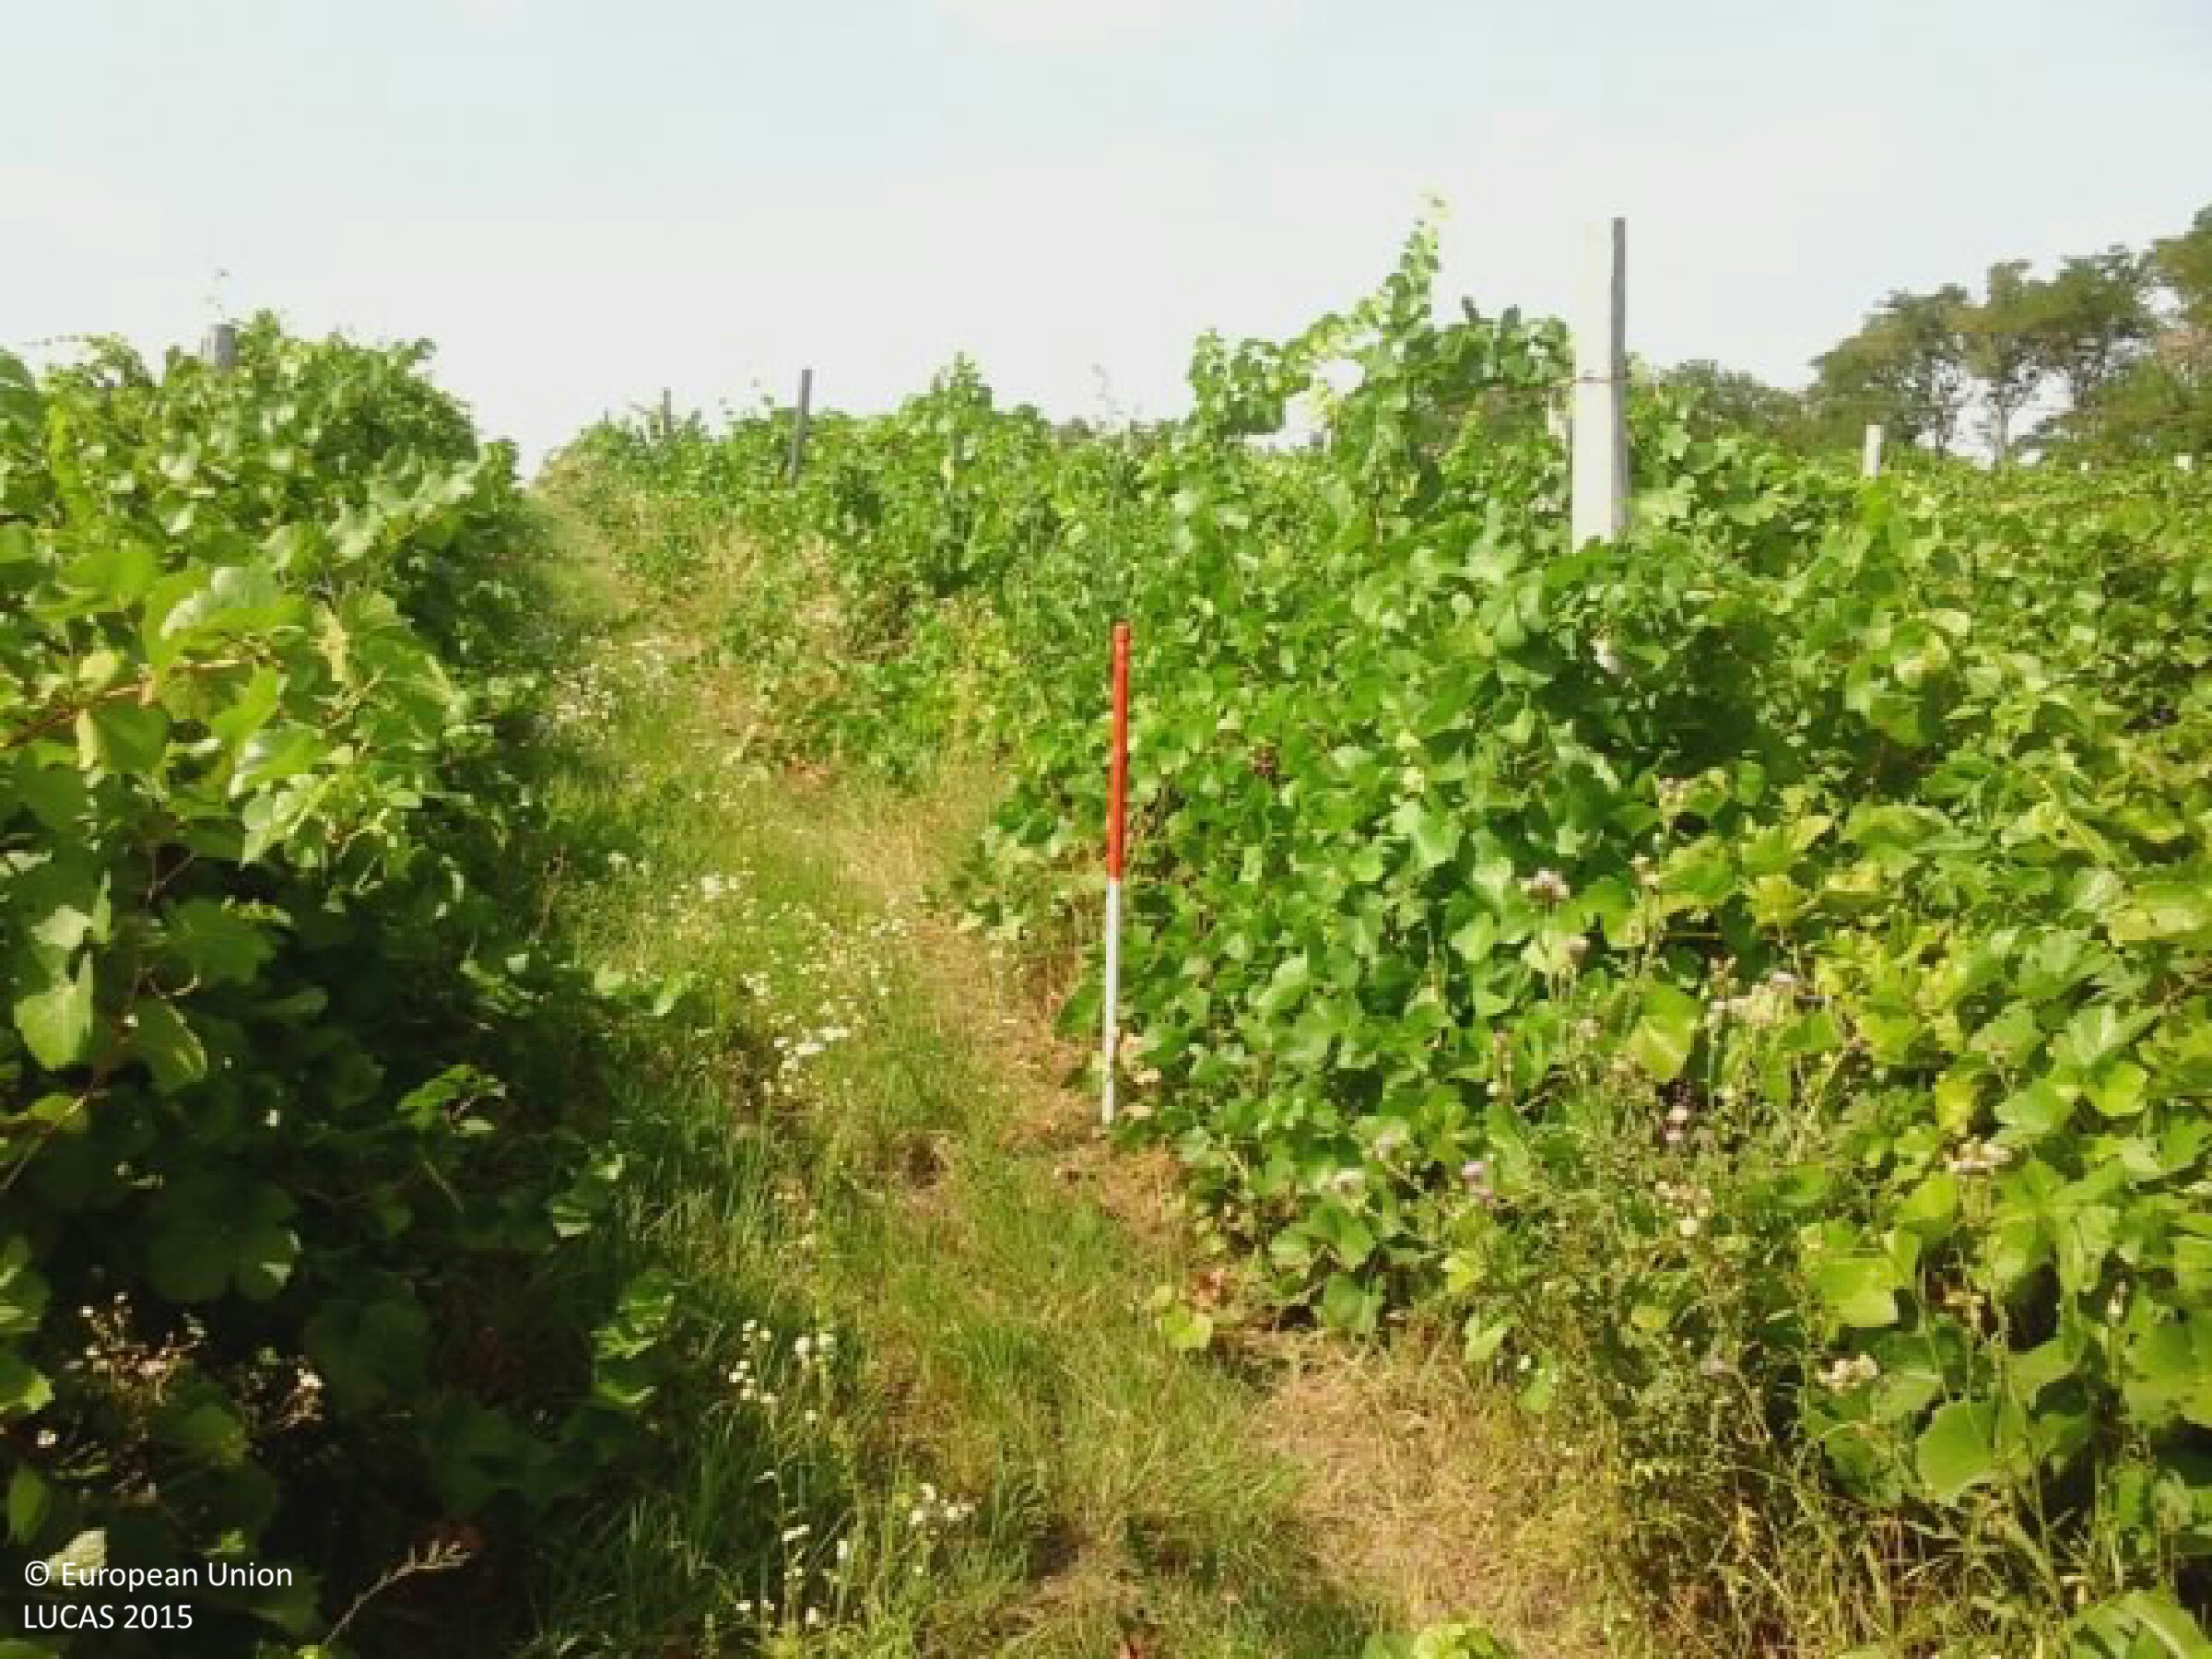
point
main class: Cropland
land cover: Vineyards
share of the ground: 50 - 75 %
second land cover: Grassland without tree/shrub cover
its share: 50 - 75 %
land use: Agriculture (excluding fallow land and kitchen gardens)
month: August
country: HU
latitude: 46.7724
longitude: 18.2733
